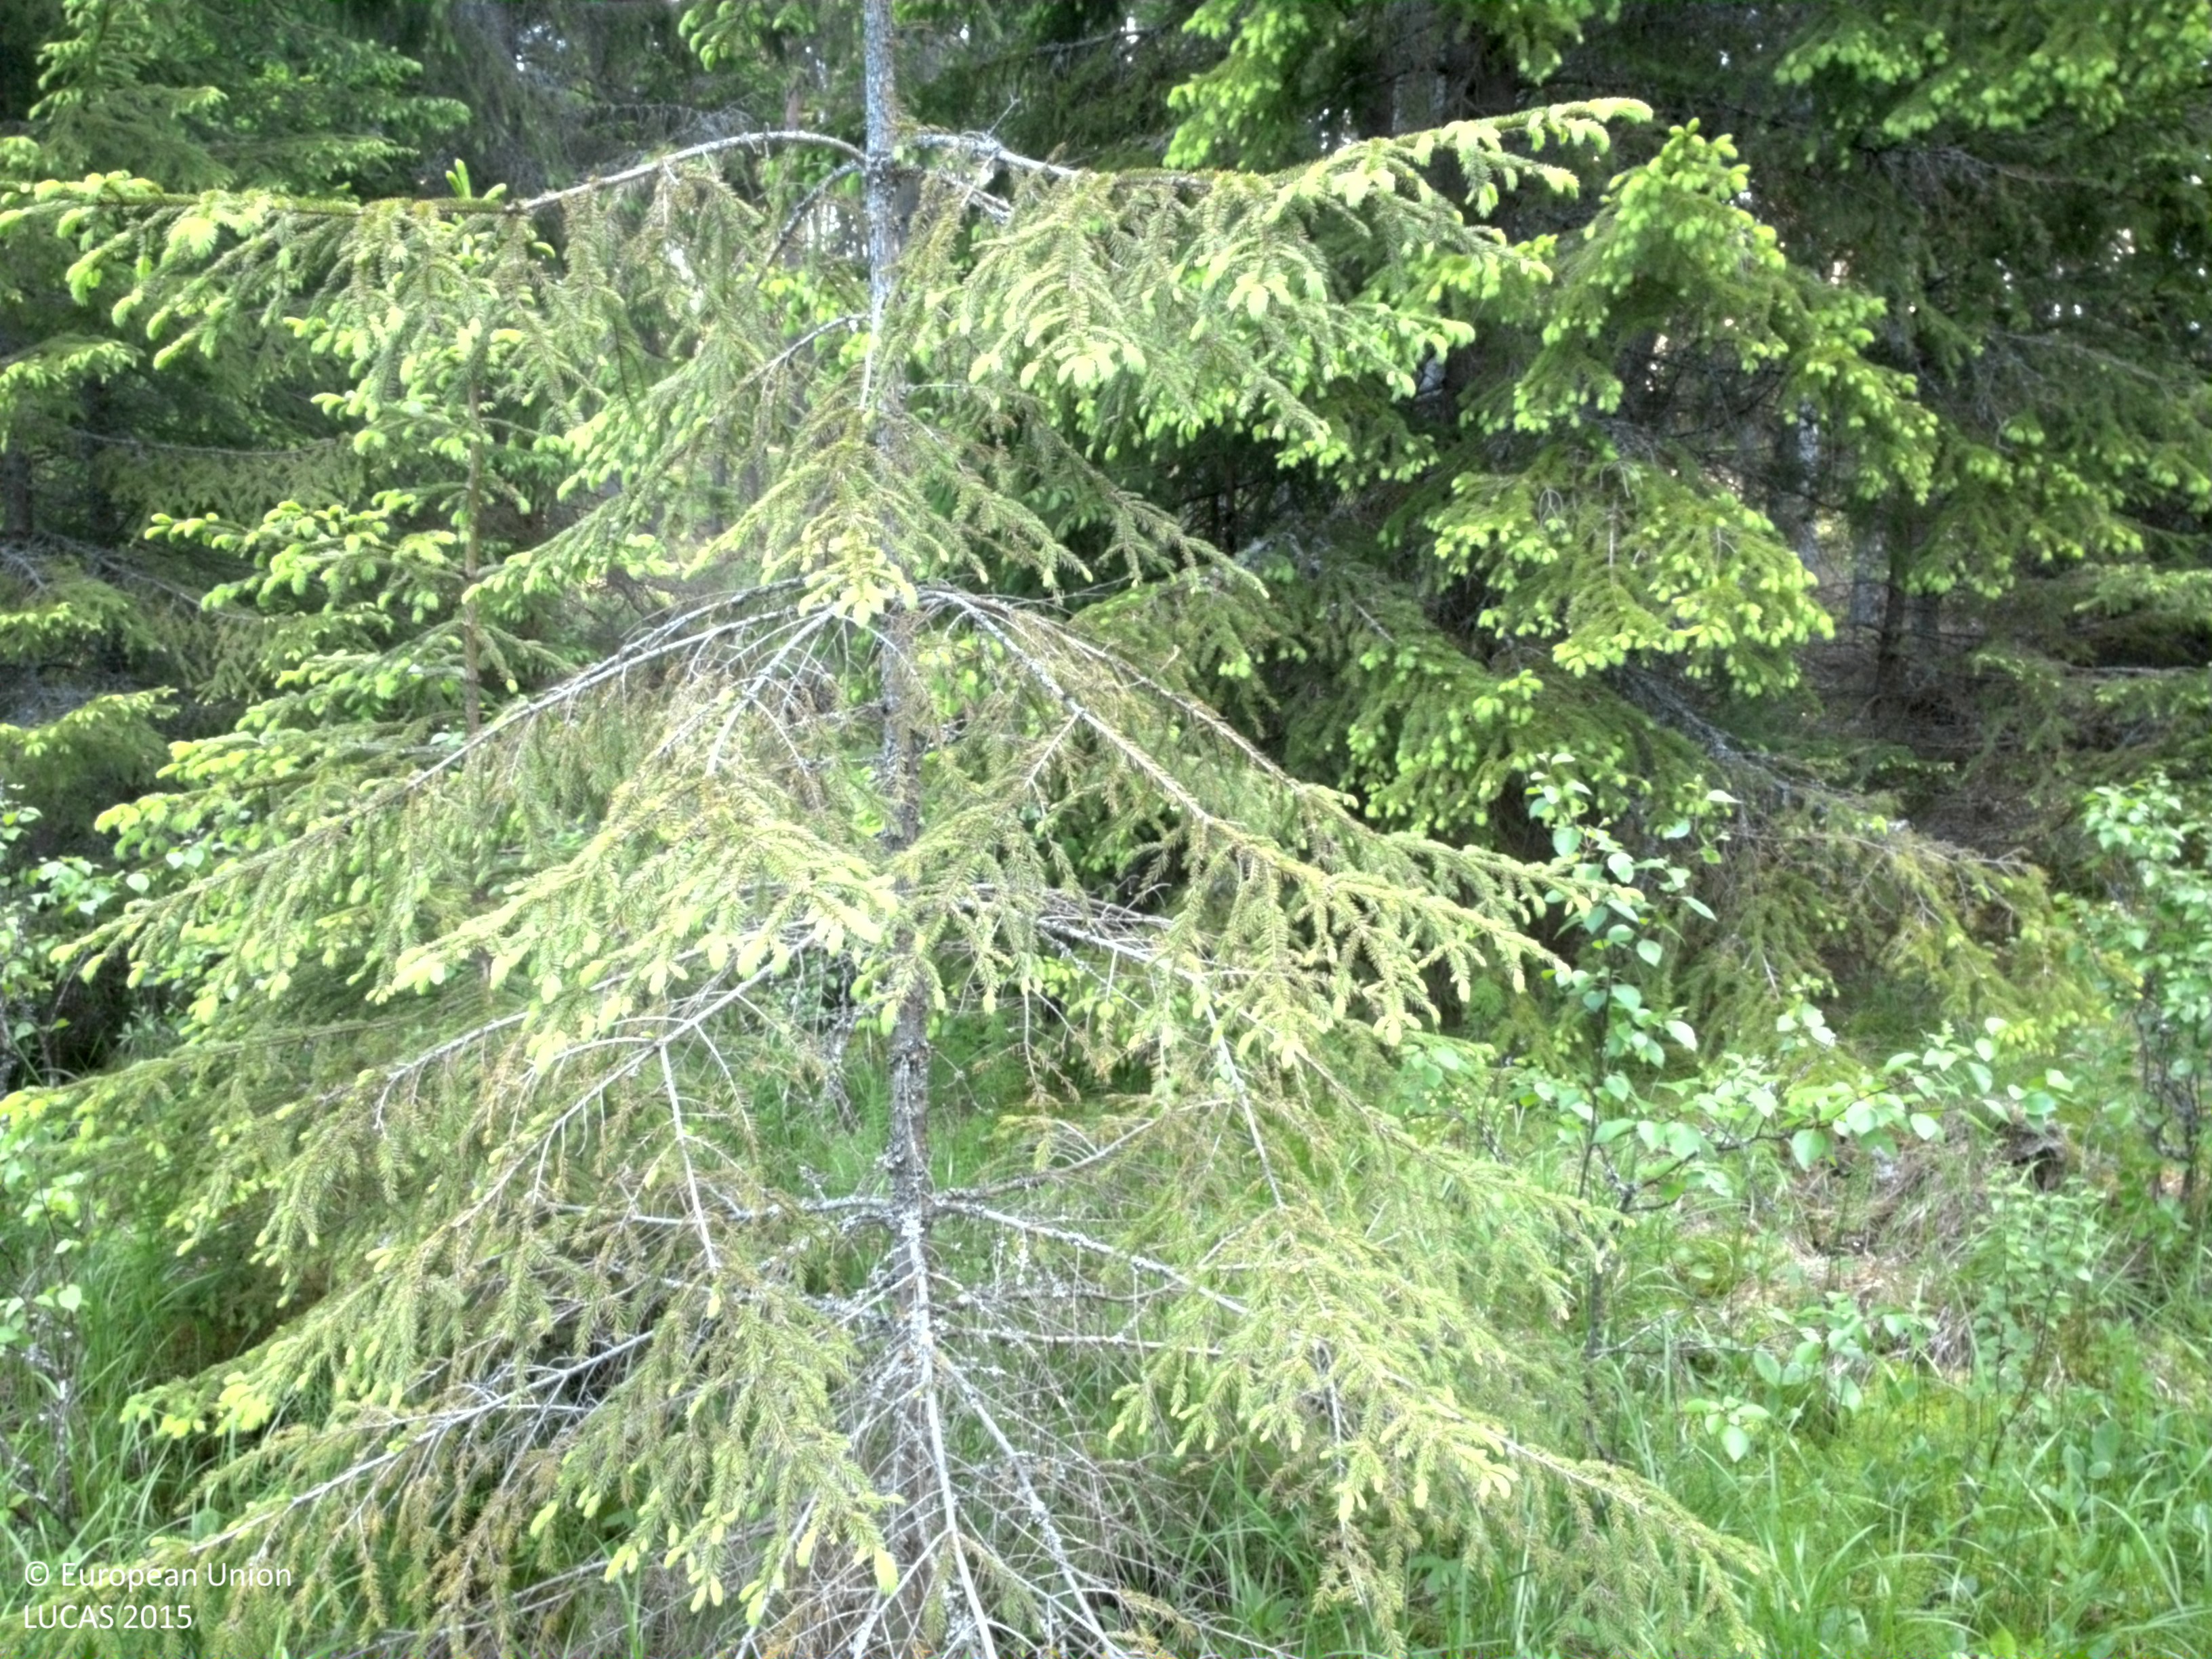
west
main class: Woodland
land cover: Spruce dominated mixed woodland
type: mire and swamp forests
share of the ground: 50 - 75 %
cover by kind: herbaceous plants 35 %, broadleaved forest trees 30 %, coniferous forest trees 20 %, lichens and mosses 15 %
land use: Semi-natural and natural areas not in use
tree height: > 5 m
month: June
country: SE
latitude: 59.6158
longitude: 14.1209
